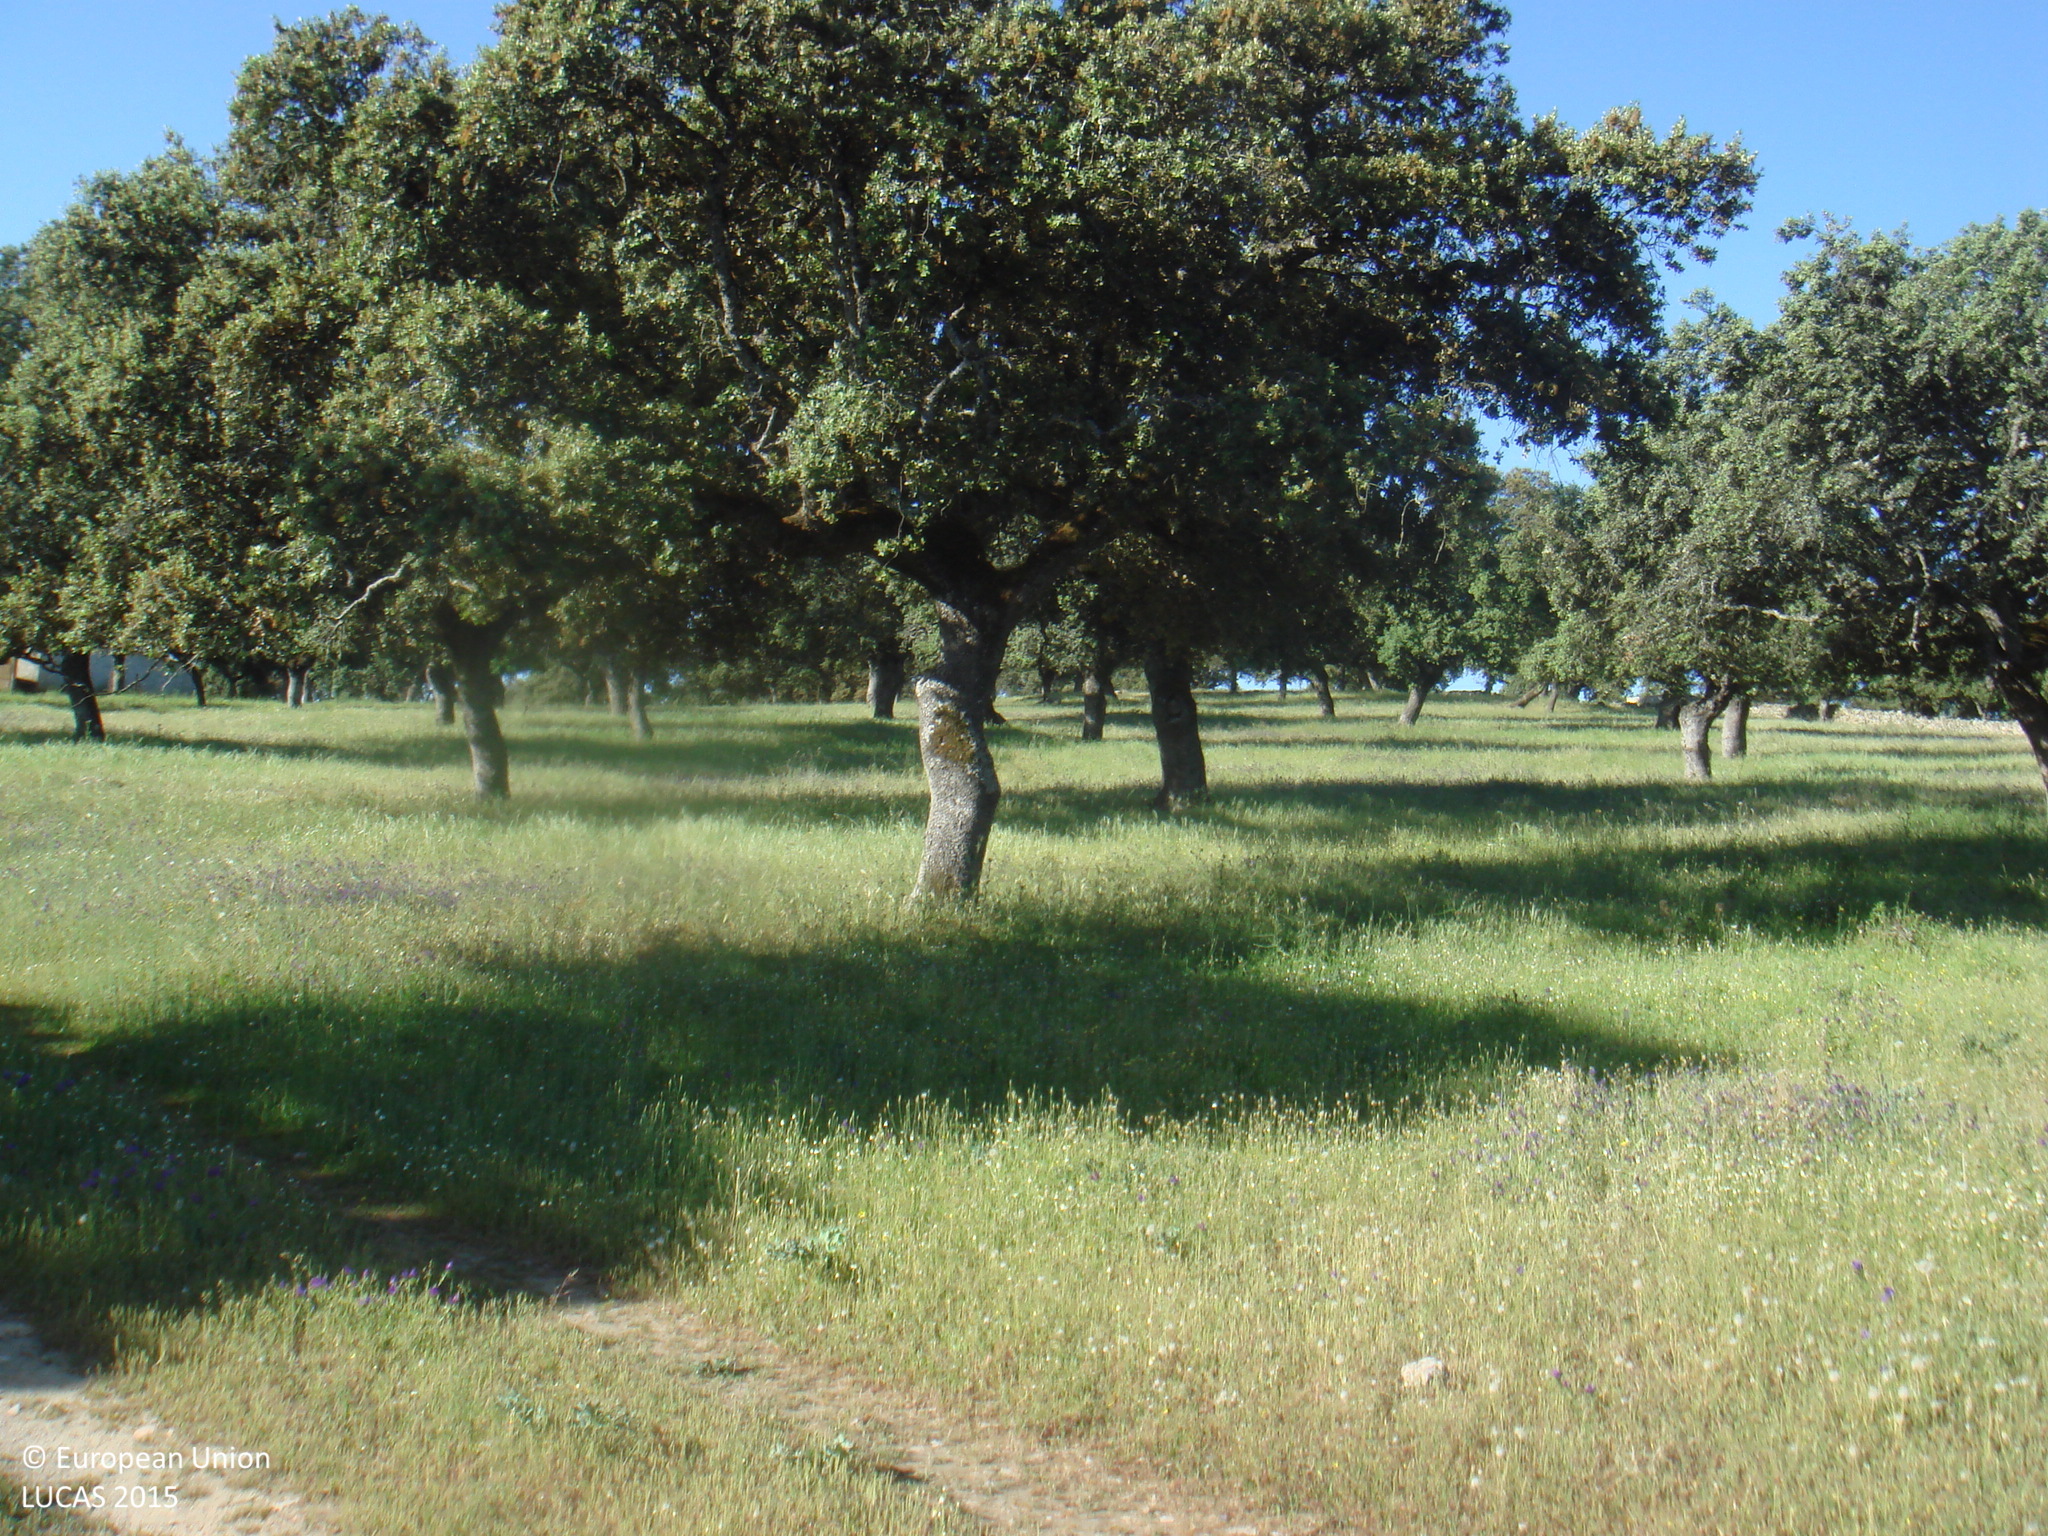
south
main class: Woodland
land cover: Broadleaved woodland
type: broadleaved evergreen forest
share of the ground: 50 - 75 %
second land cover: Spontaneously vegetated surfaces
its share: > 75 %
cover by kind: broadleaved forest trees 50 %, herbaceous plants 50 %
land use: Forestry
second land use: Agriculture (excluding fallow land and kitchen gardens)
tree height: > 5 m
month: May
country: ES
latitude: 38.3203
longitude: -4.7417
